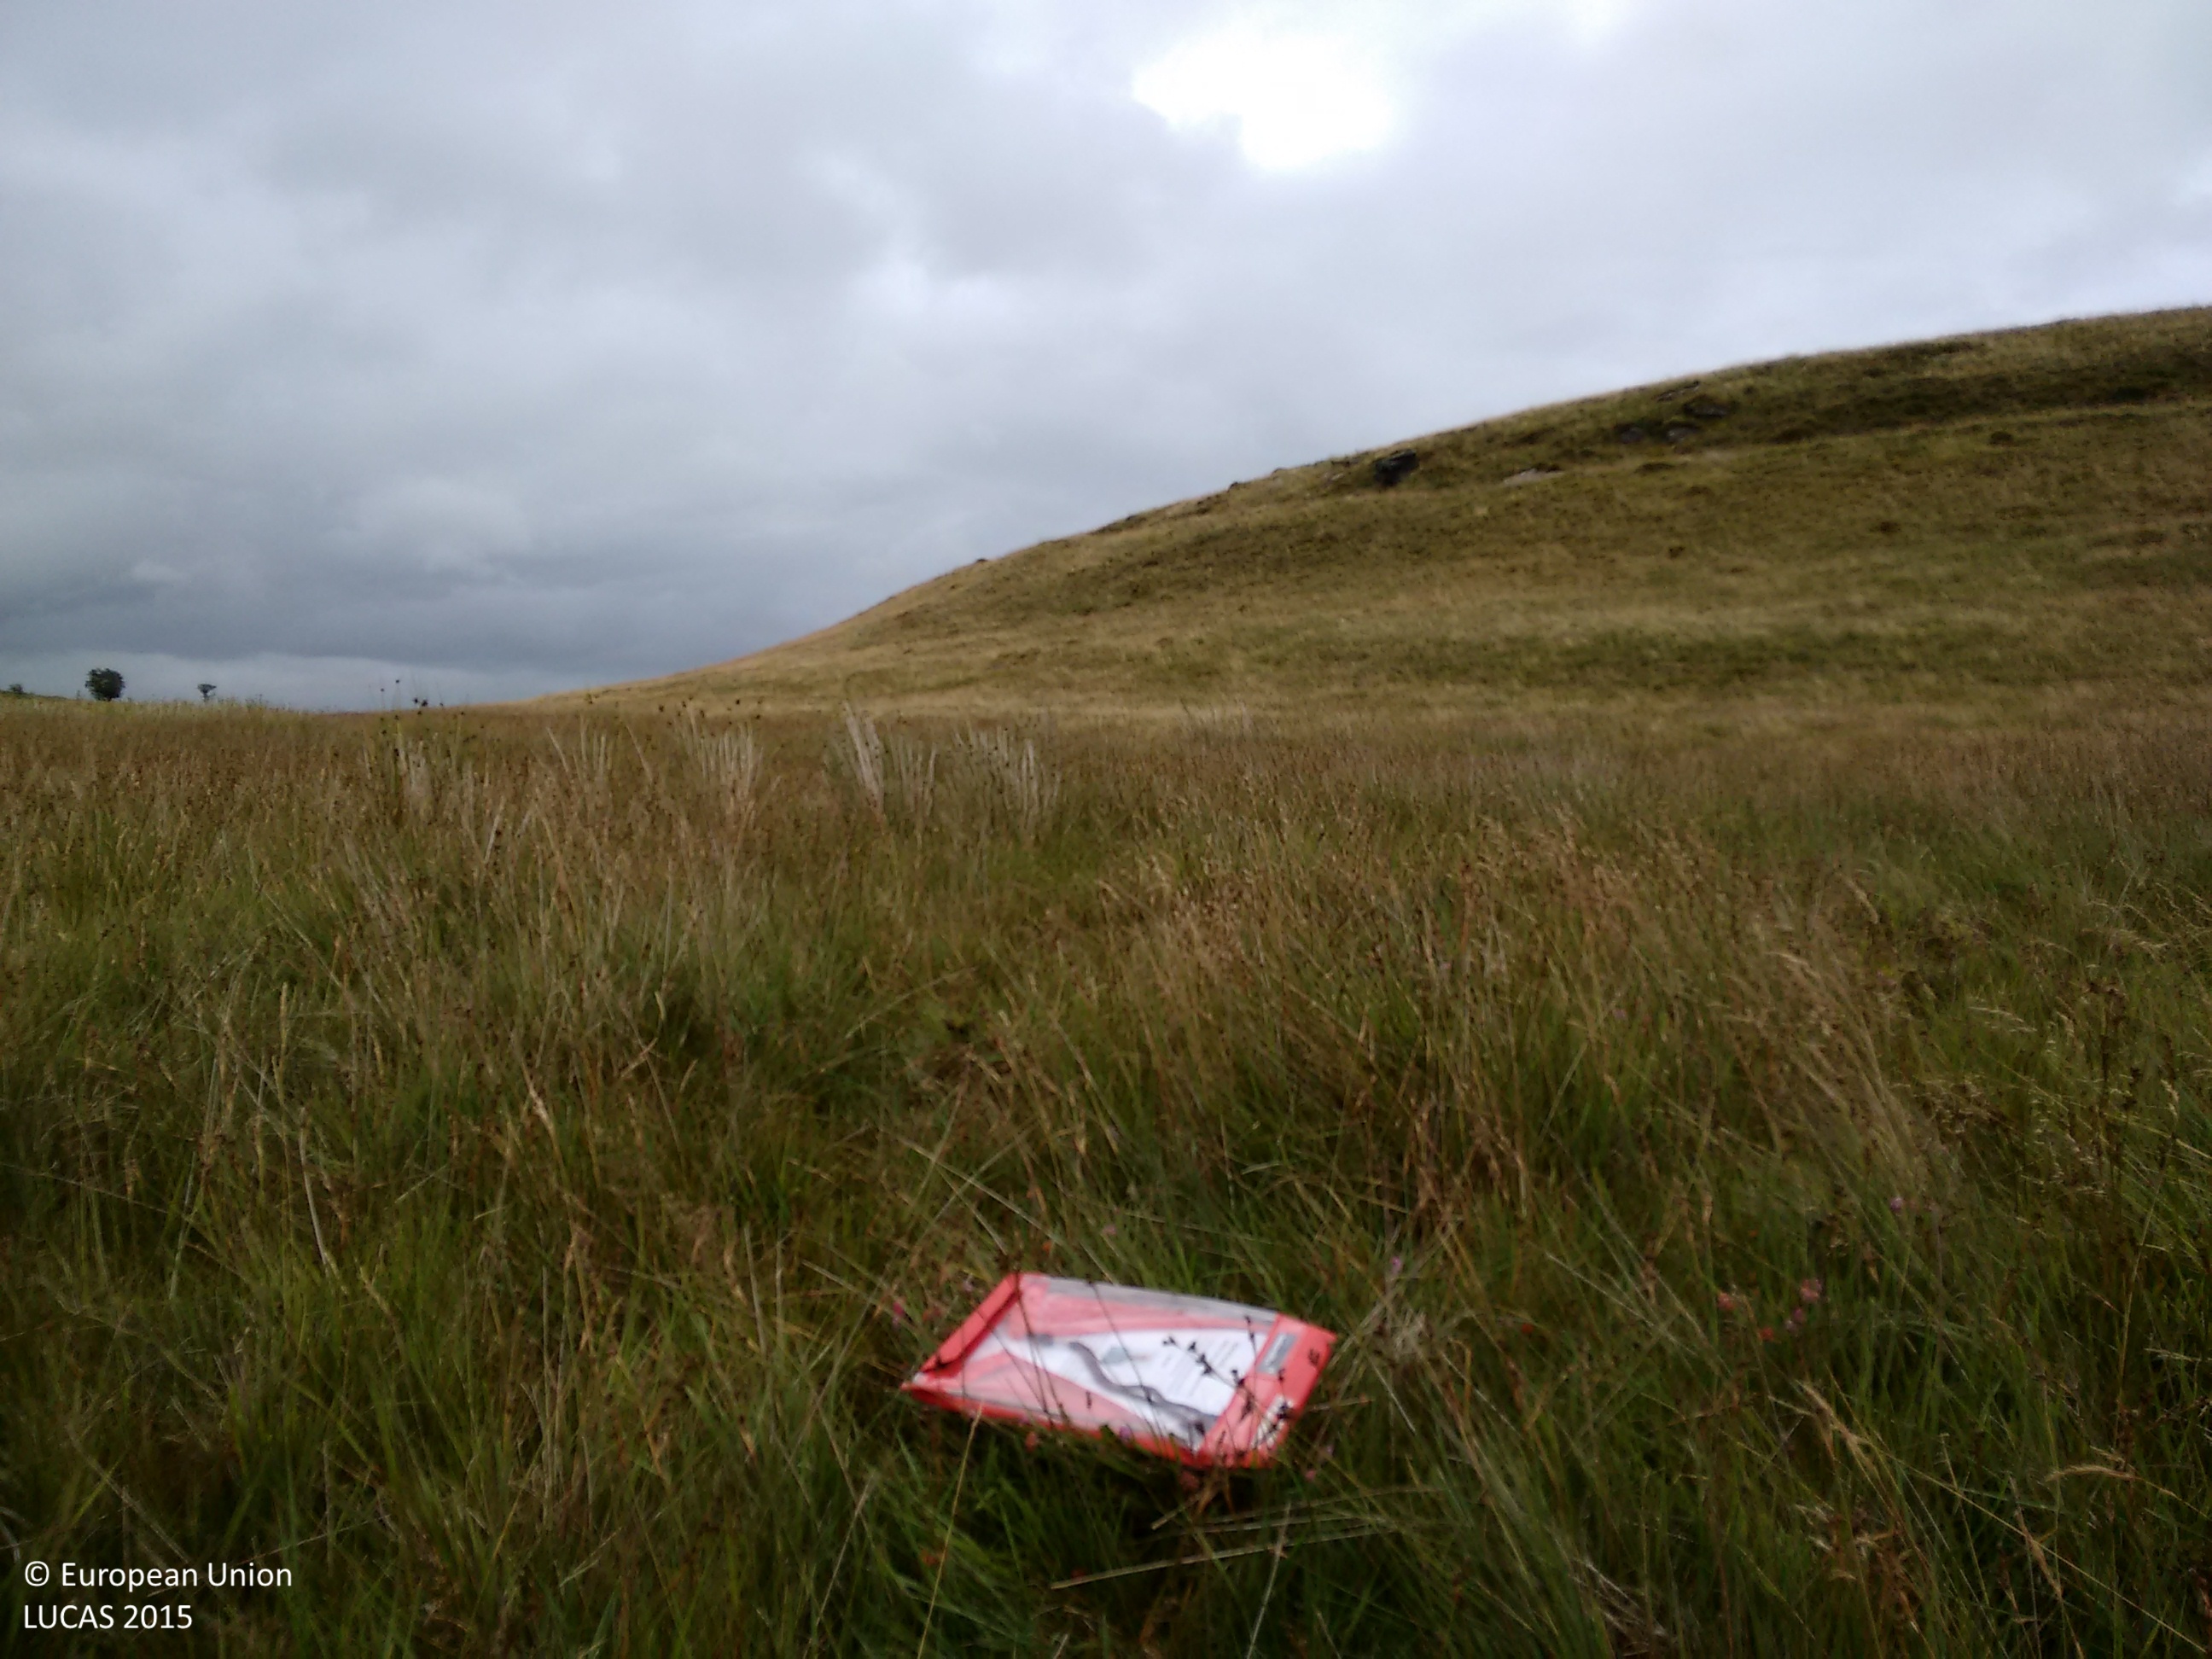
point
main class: Grassland
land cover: Grassland without tree/shrub cover
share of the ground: > 75 %
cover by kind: herbaceous plants 100 %
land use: Agriculture (excluding fallow land and kitchen gardens)
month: July
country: GB
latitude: 51.7621
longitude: -3.8414
